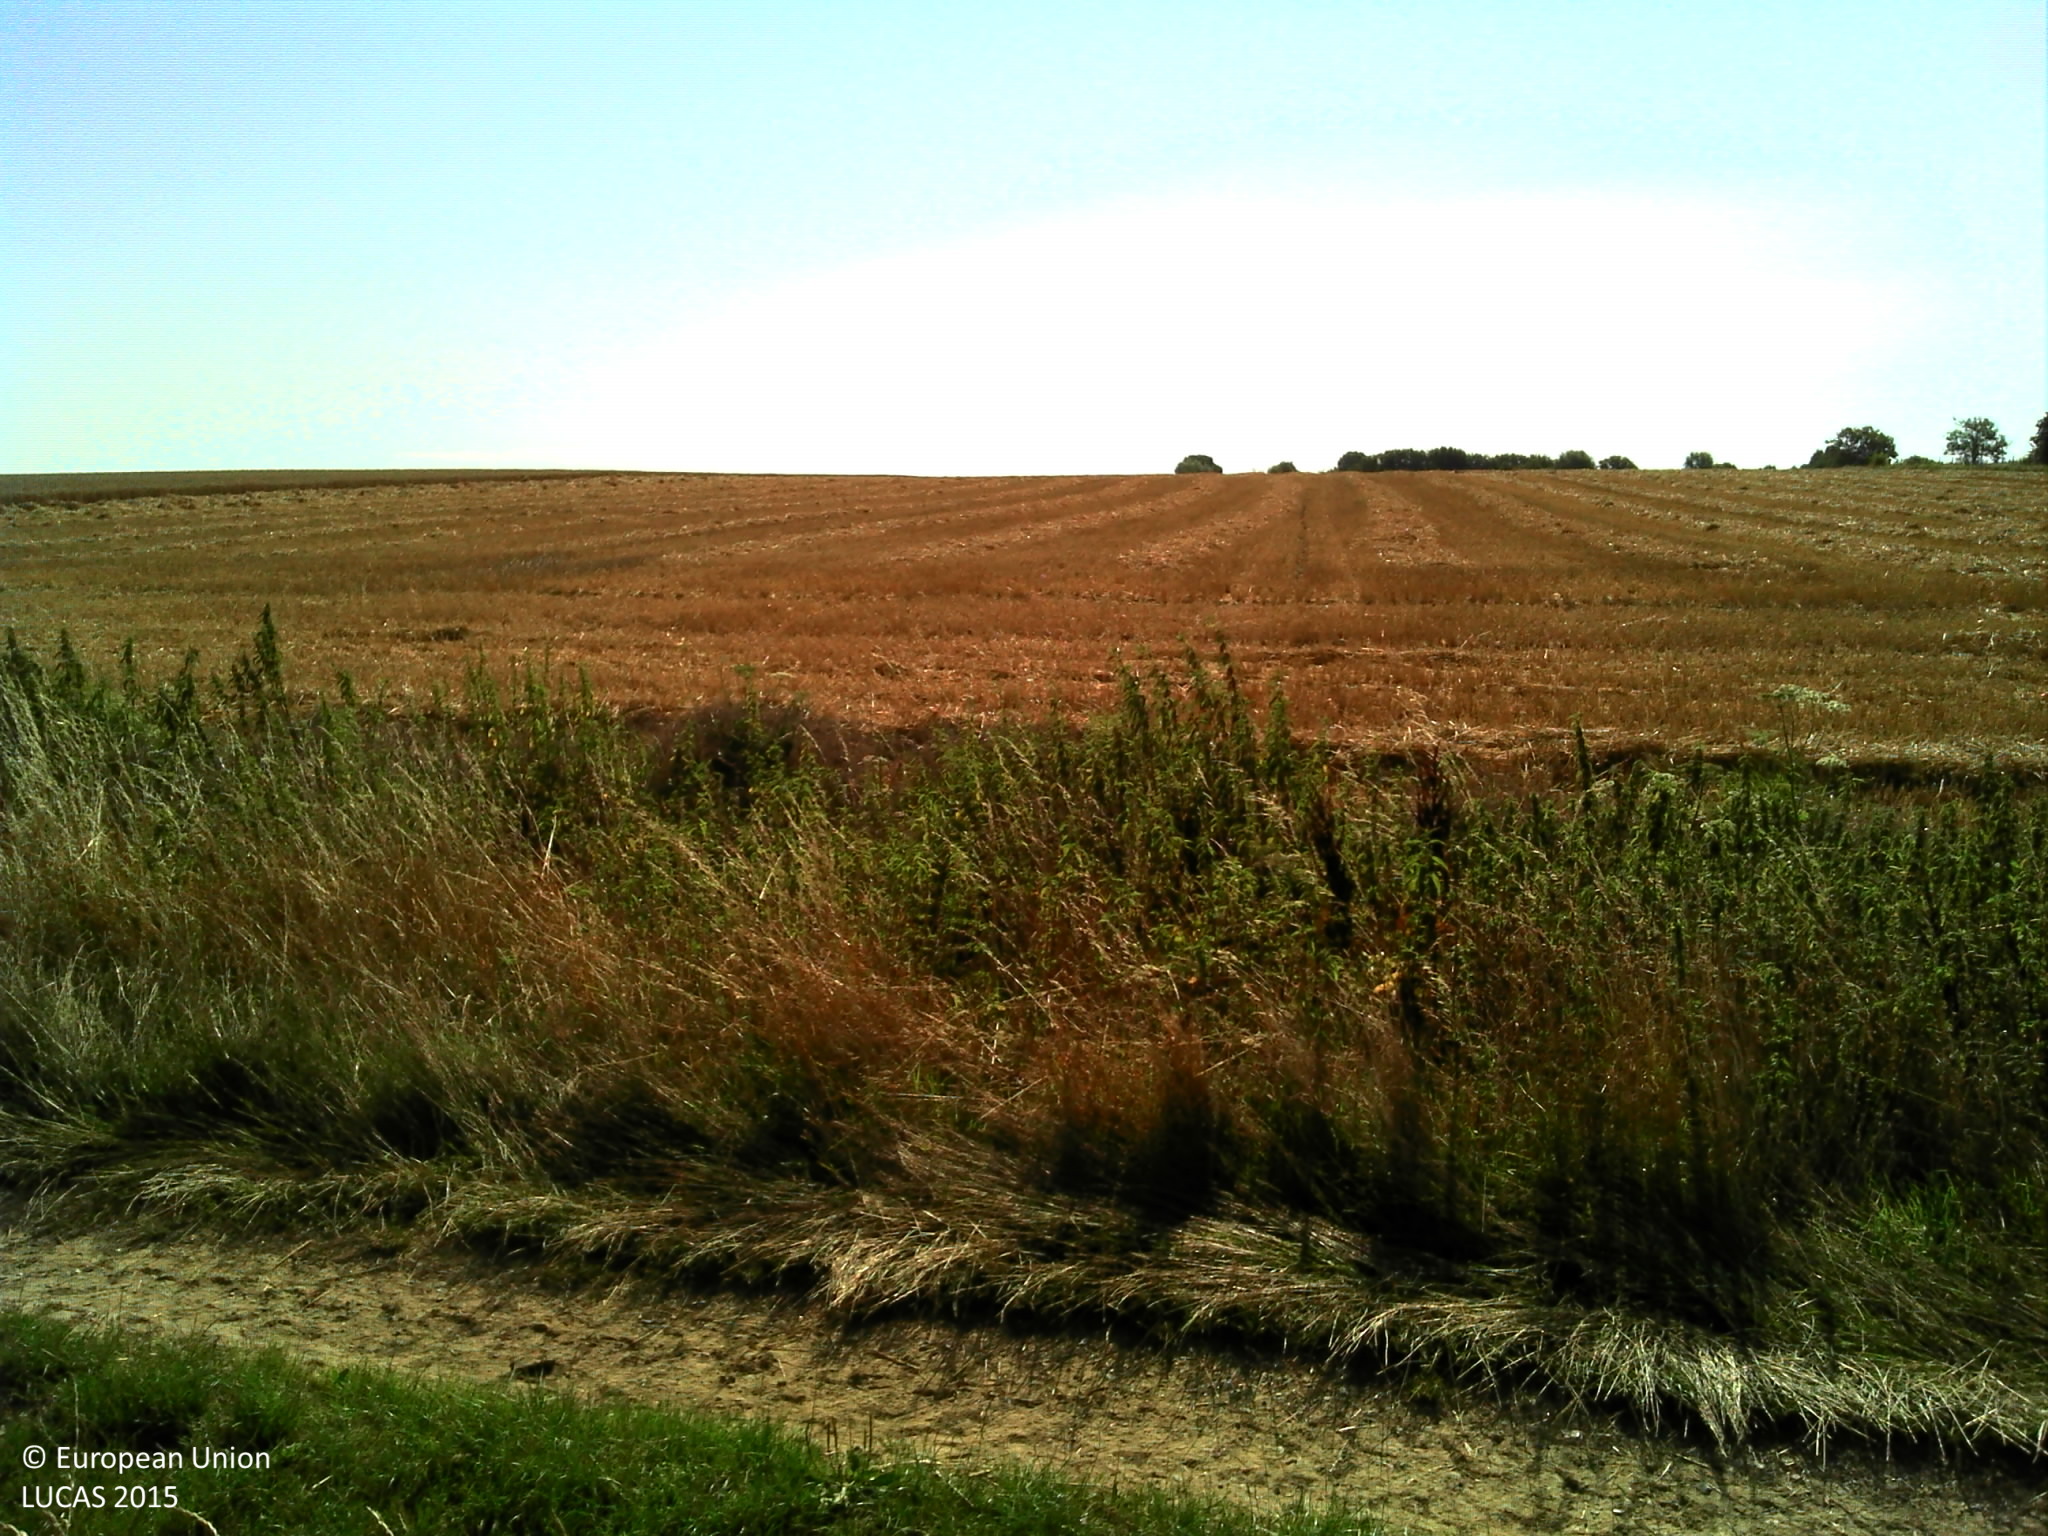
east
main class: Cropland
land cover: Maize
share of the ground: > 75 %
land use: Agriculture (excluding fallow land and kitchen gardens)
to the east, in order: Maize; Grass margins; Tracks; Grass margins; Ditches and canals; Grass margins; Common wheat
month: August
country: FR
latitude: 50.1684
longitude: 3.9601
